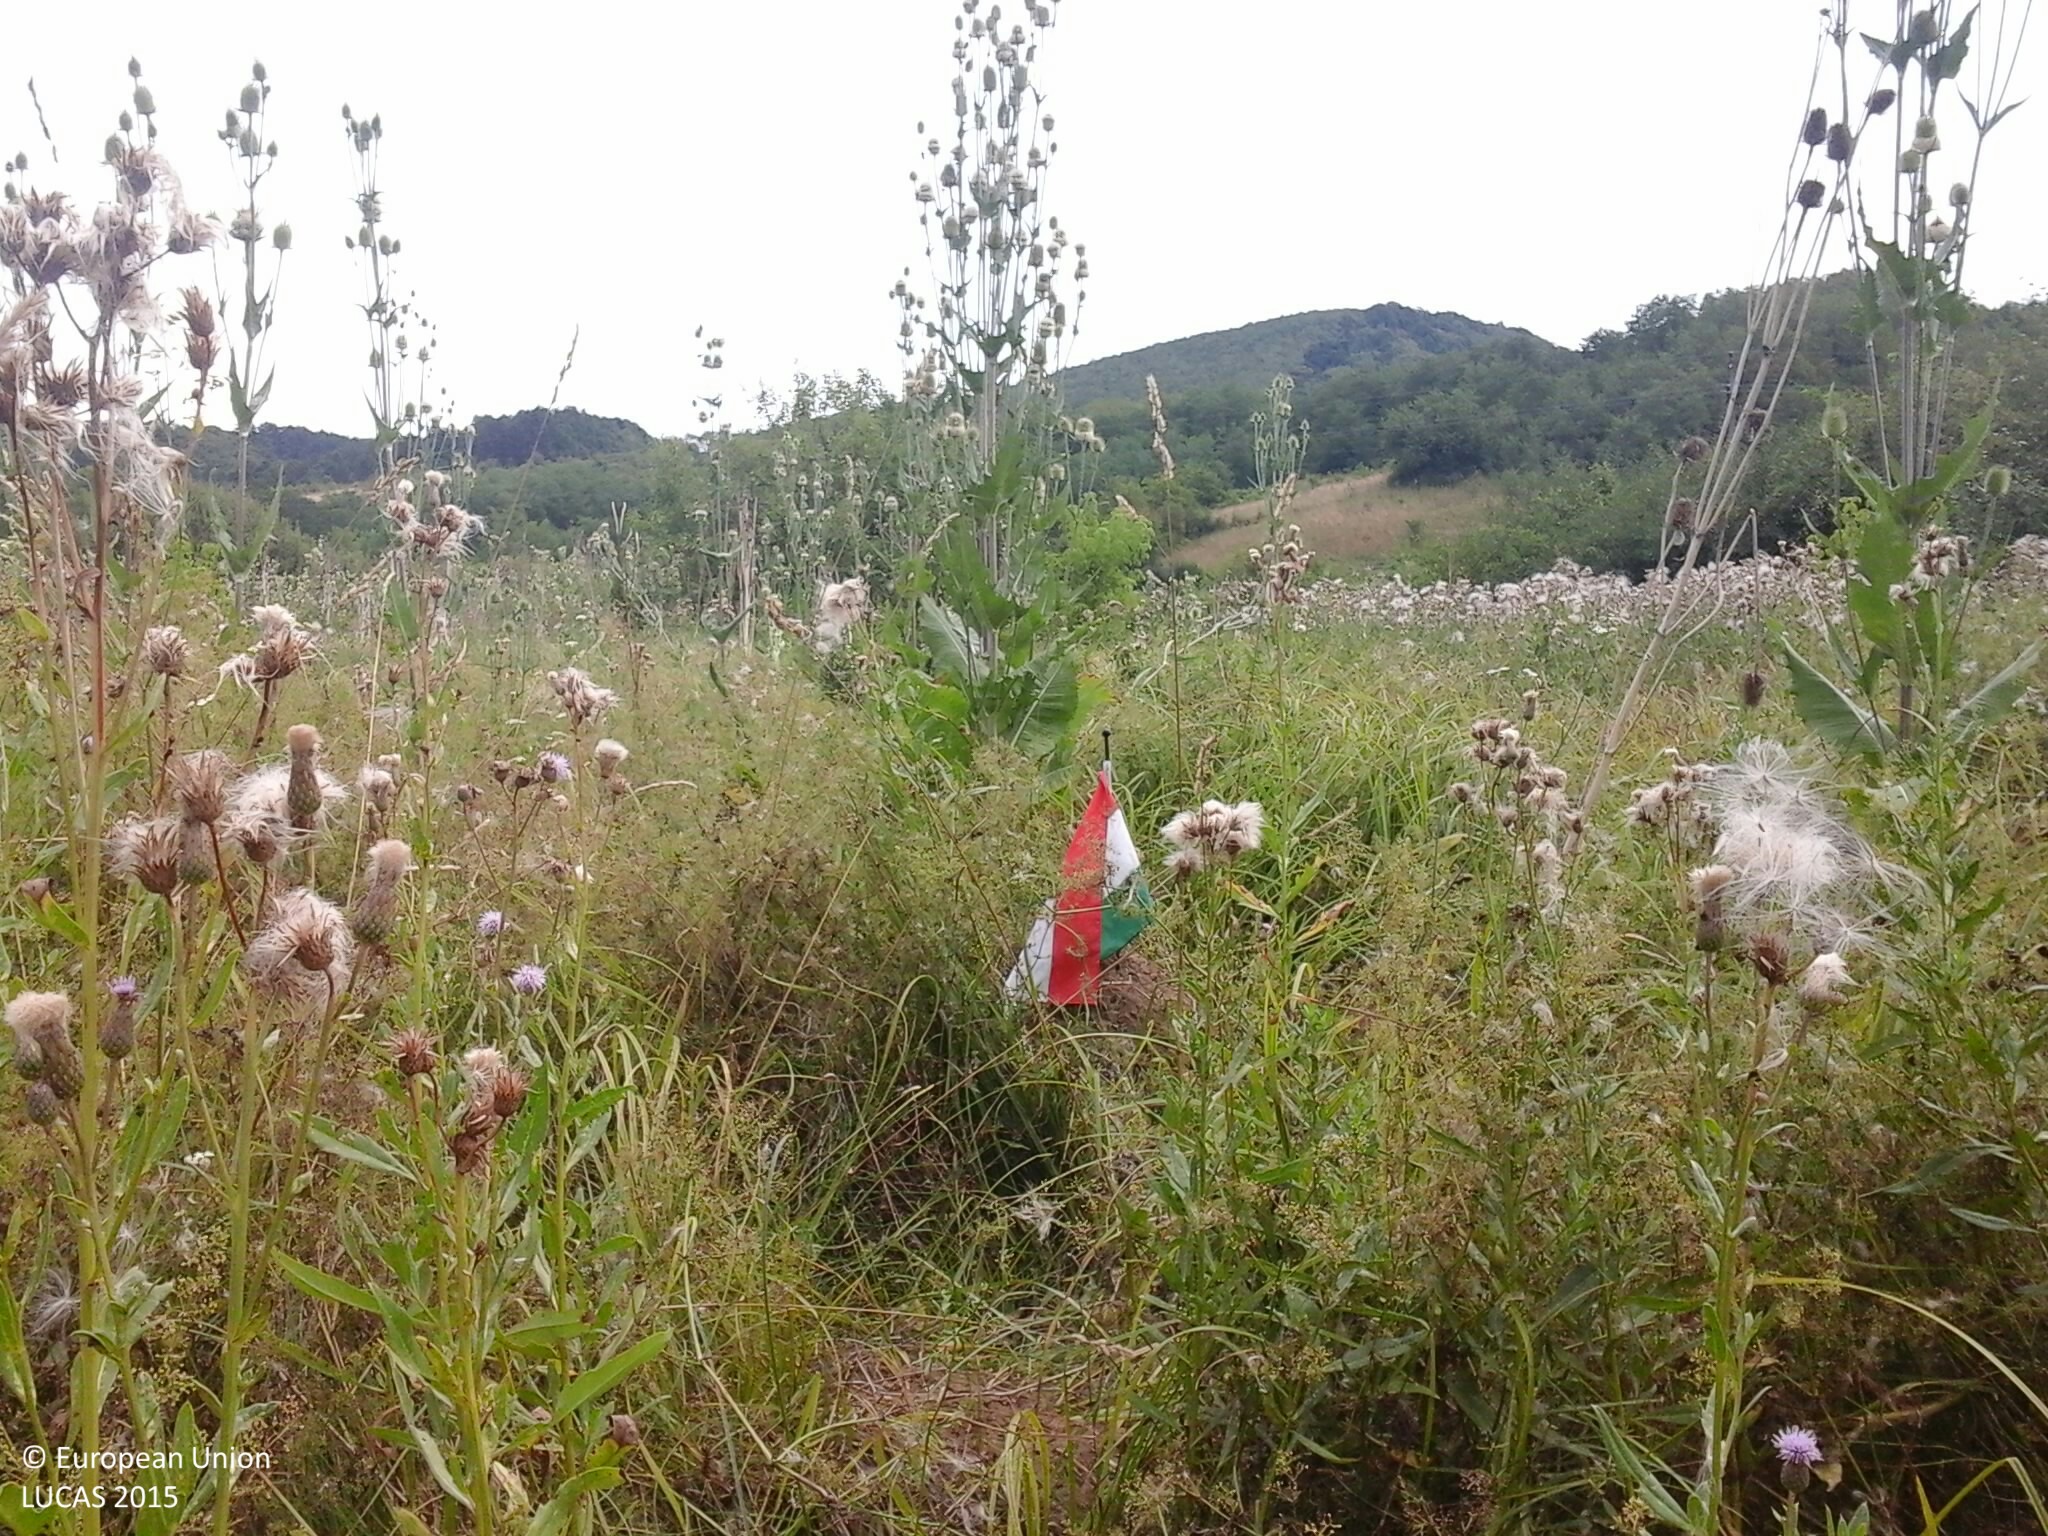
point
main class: Grassland
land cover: Grassland with sparse tree/shrub cover
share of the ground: > 75 %
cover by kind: herbaceous plants 95 %, broadleaved forest trees 5 %
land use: Semi-natural and natural areas not in use
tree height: < 5 m
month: July
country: HU
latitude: 47.9229
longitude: 19.2685
